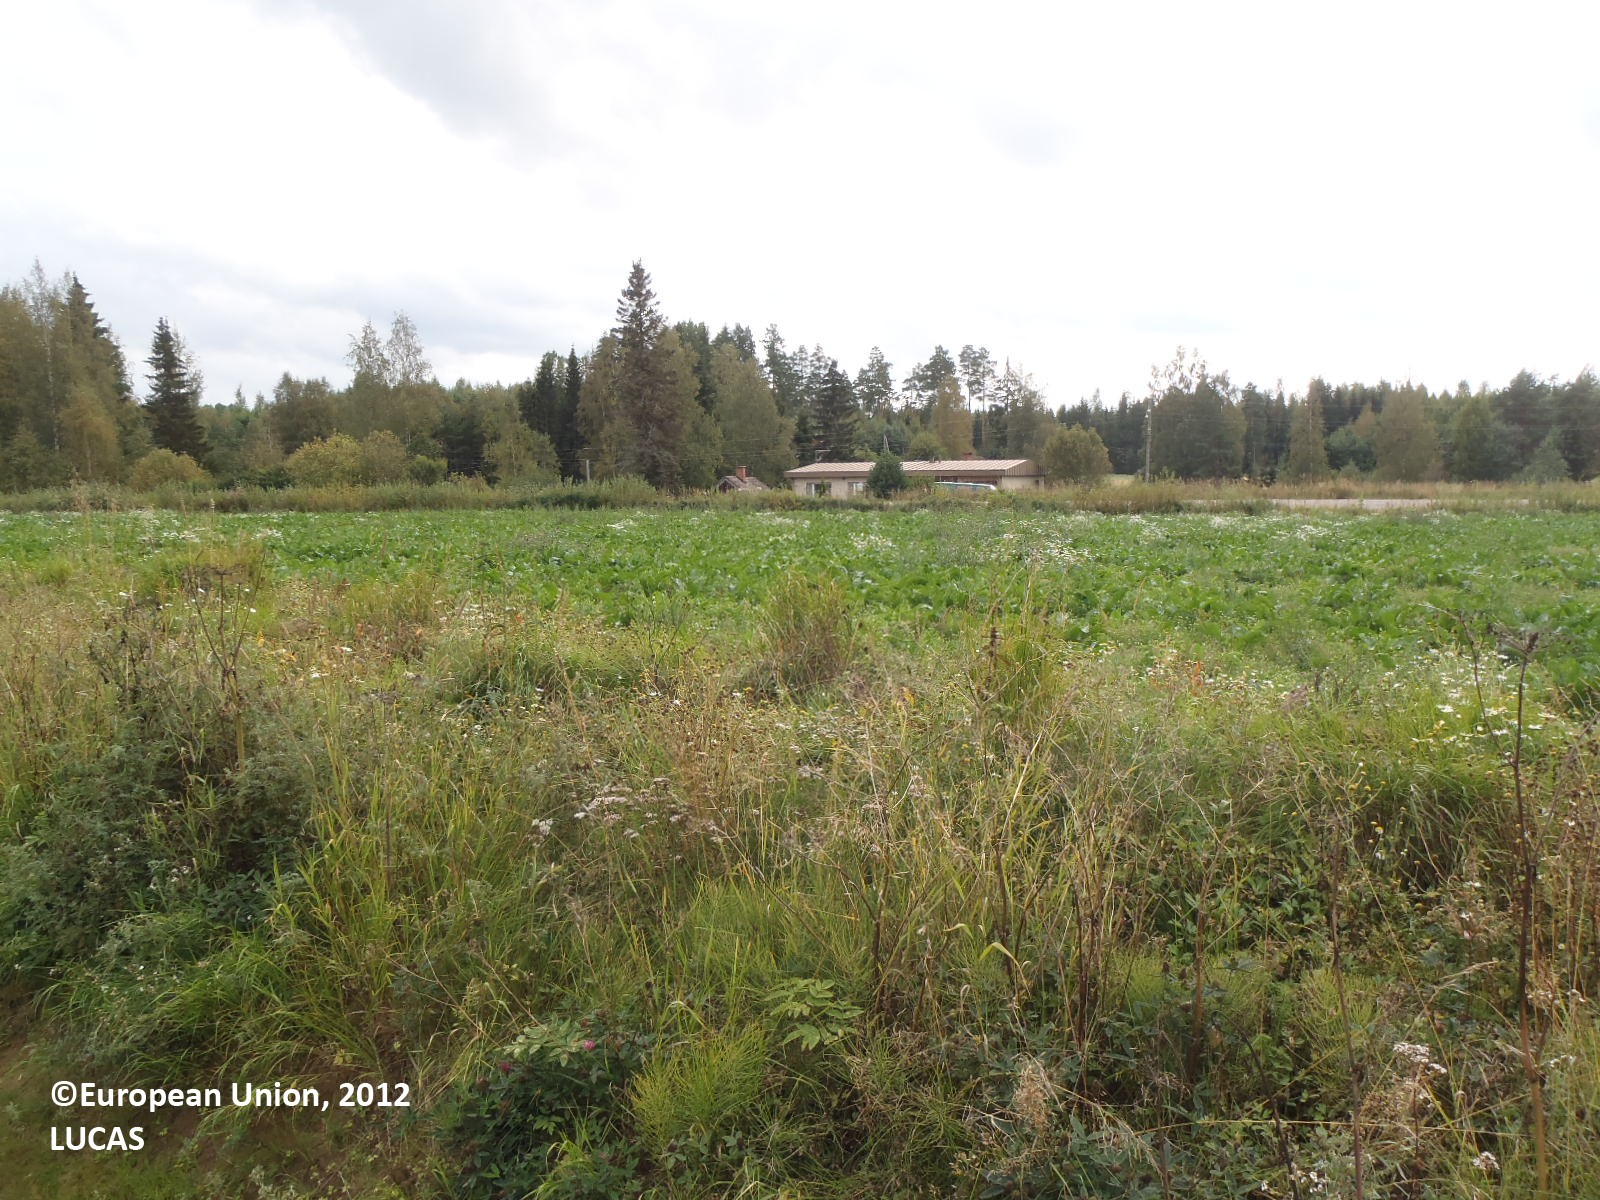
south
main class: Cropland
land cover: Barley
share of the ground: > 75 %
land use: Agriculture (excluding fallow land and kitchen gardens)
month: August
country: FI
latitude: 60.9944
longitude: 22.4717
